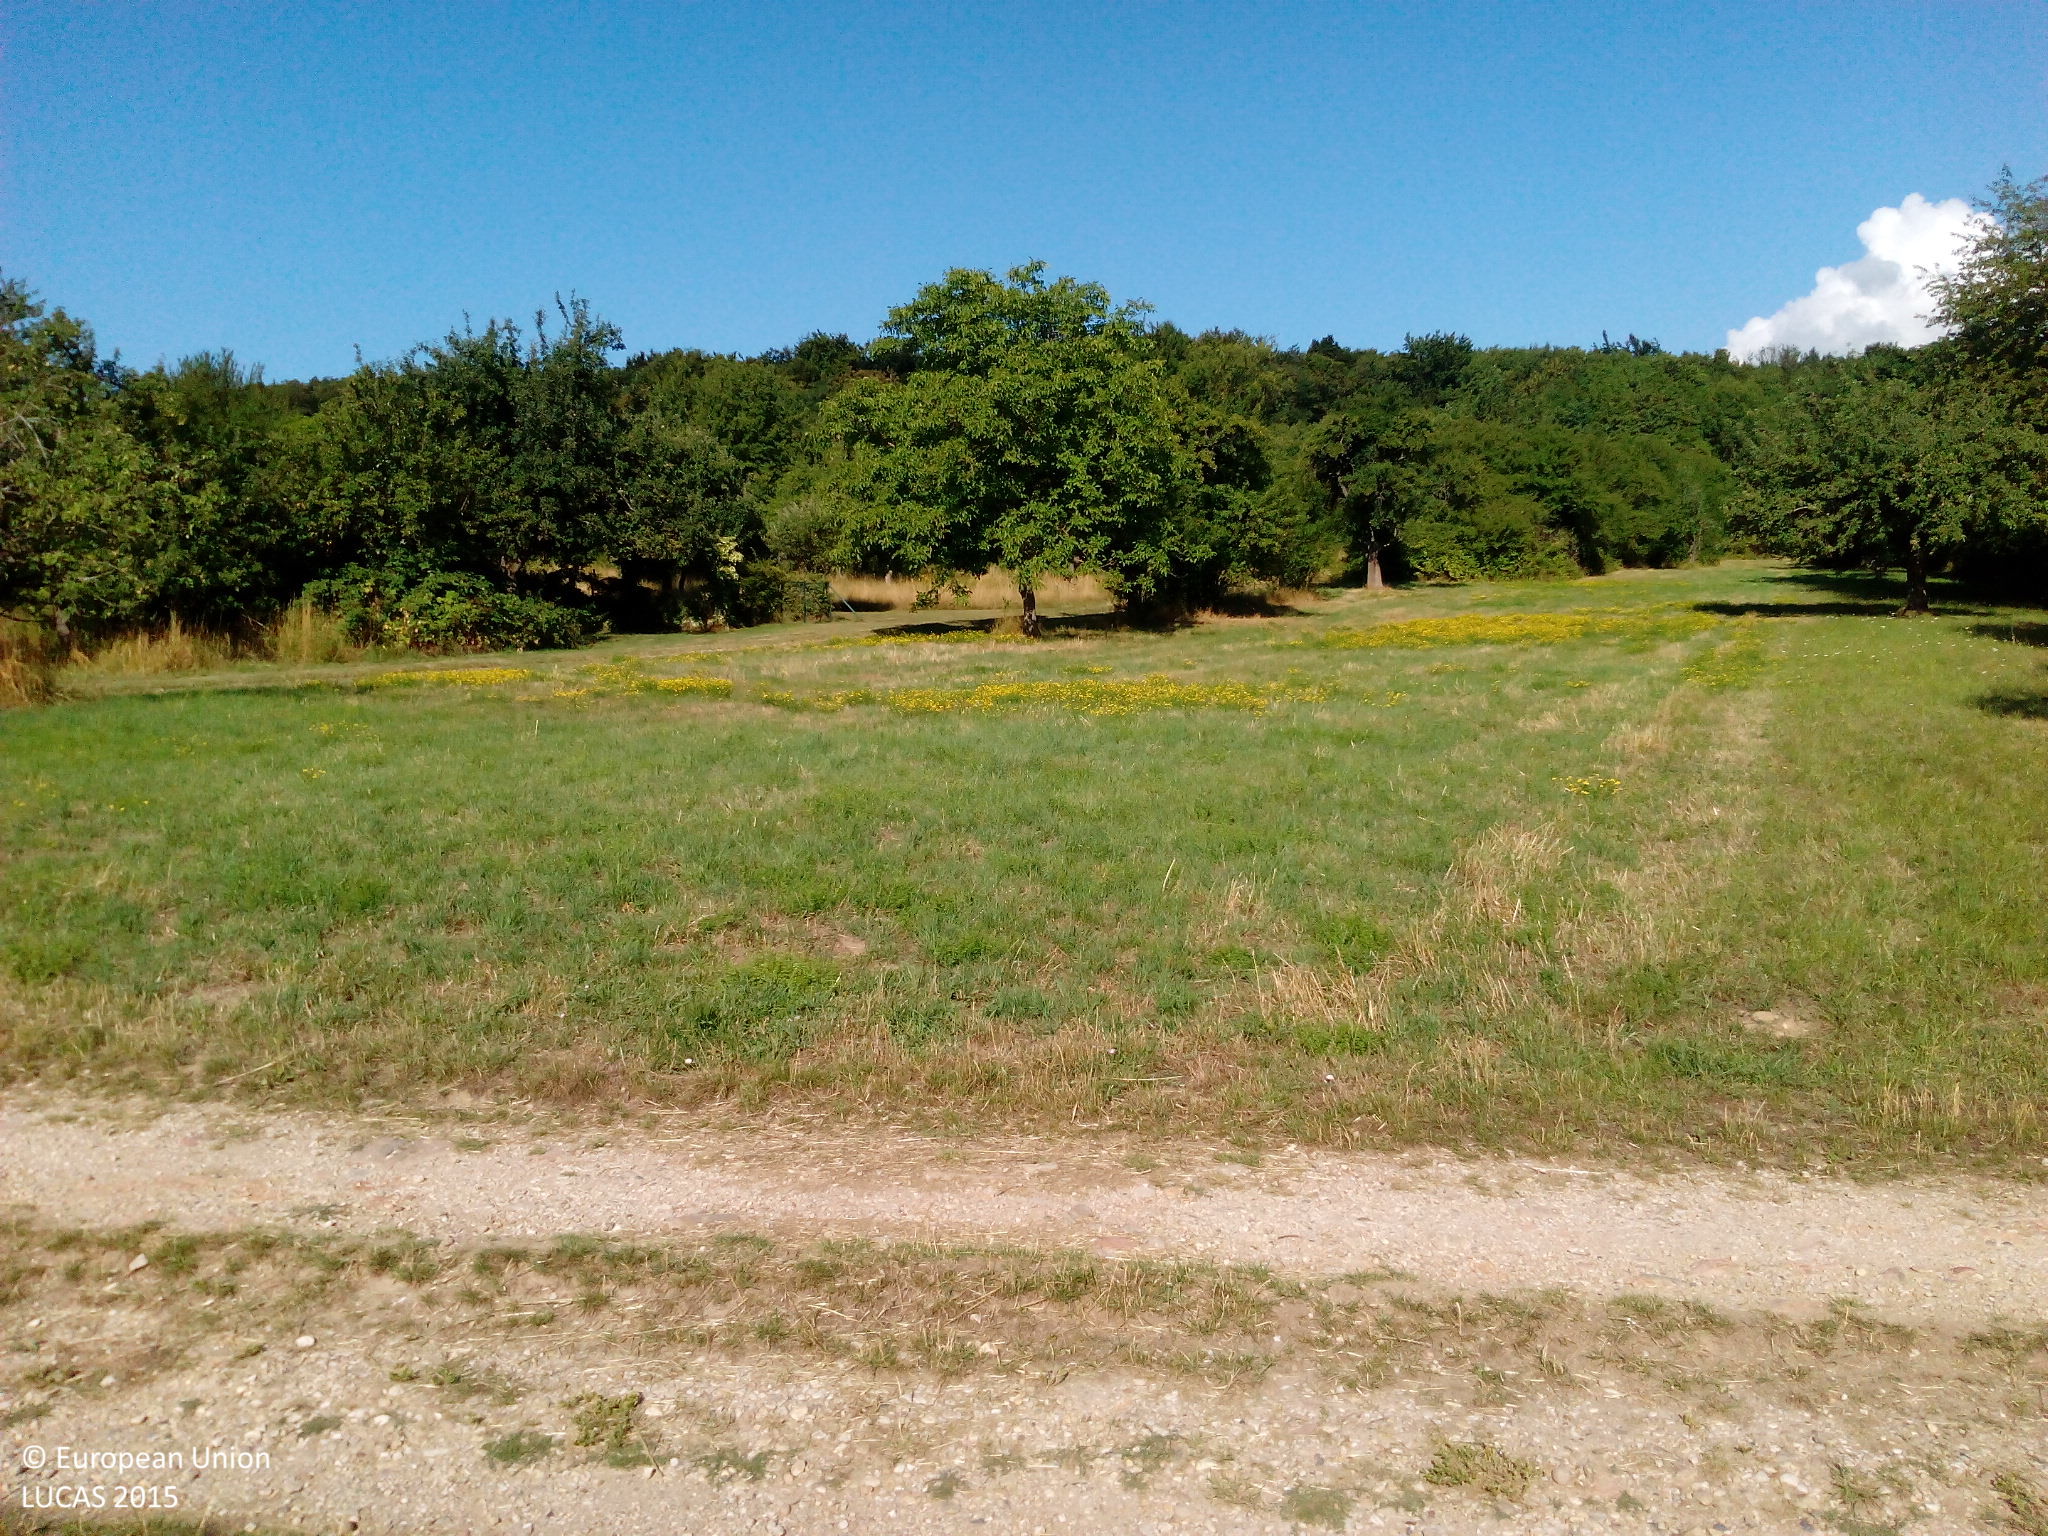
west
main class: Grassland
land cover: Grassland without tree/shrub cover
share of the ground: > 75 %
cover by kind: herbaceous plants 90 %, unconsolidated bare surface 10 %
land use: Agriculture (excluding fallow land and kitchen gardens)
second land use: Amenities, museums, leisure
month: July
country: DE
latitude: 50.1017
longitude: 8.4485
